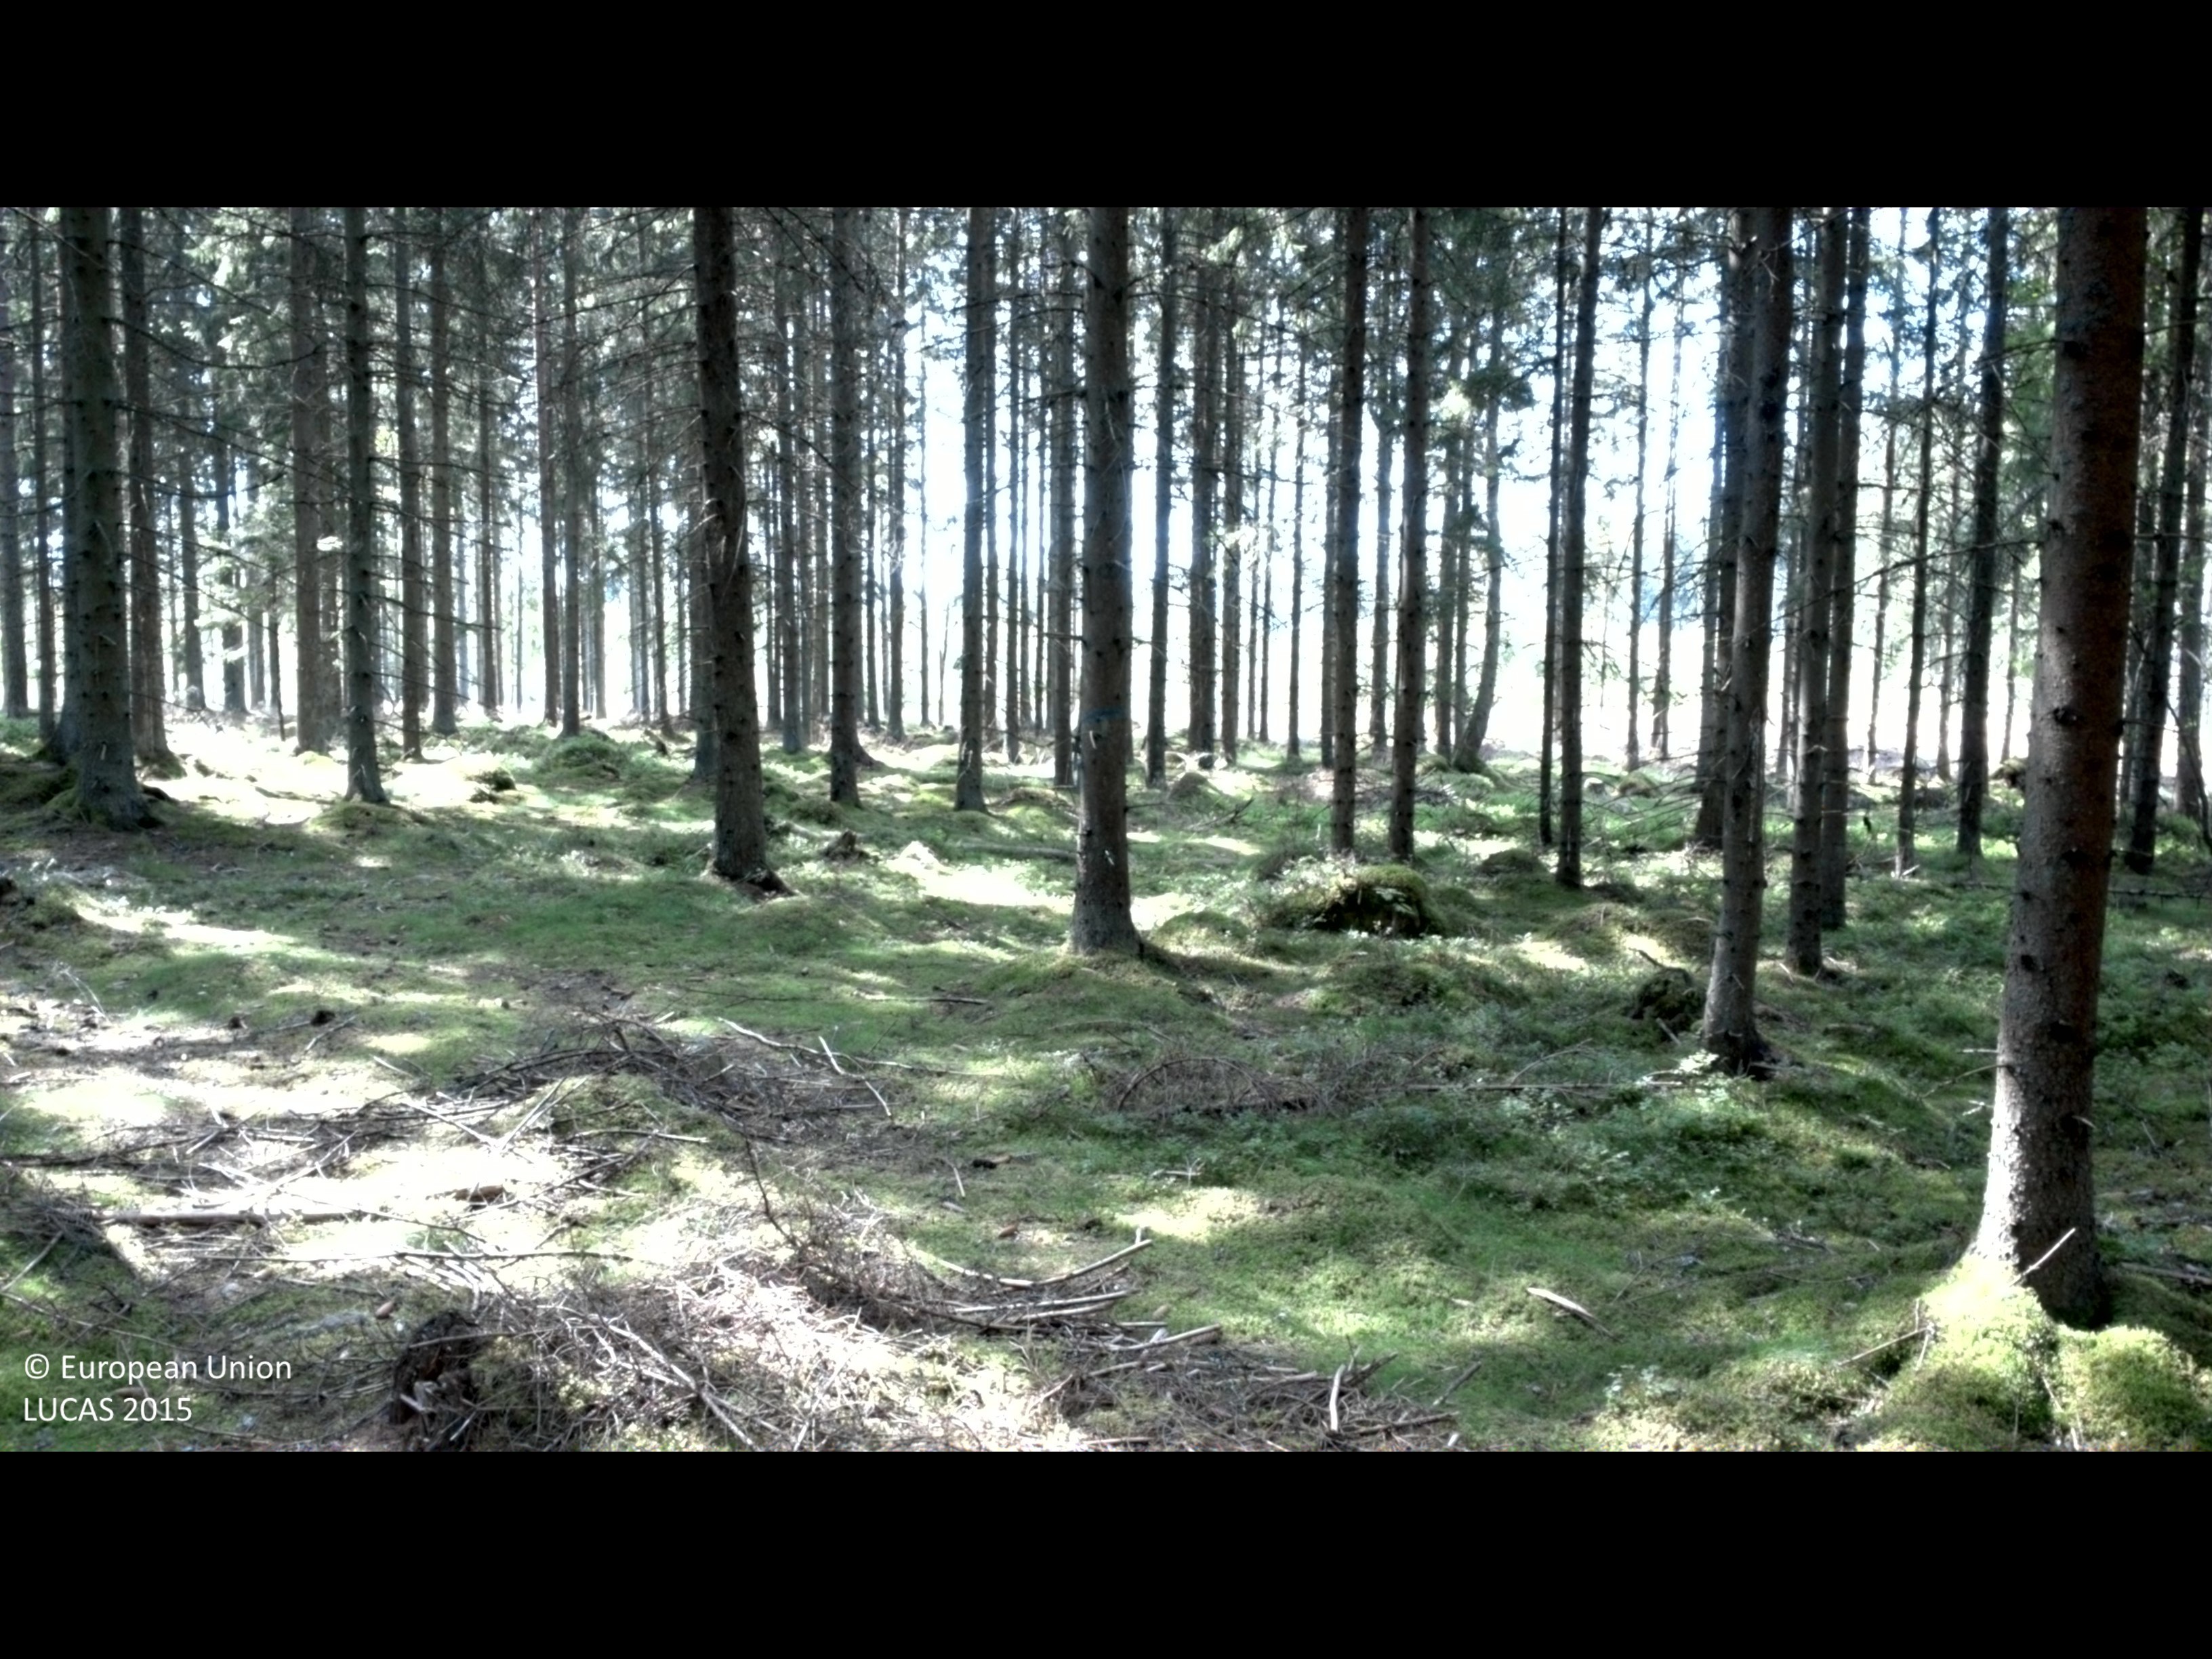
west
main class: Woodland
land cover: Spruce dominated coniferous woodland
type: boreal forest
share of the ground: > 75 %
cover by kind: coniferous forest trees 80 %, lichens and mosses 15 %, shrubs 5 %
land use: Forestry
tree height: > 5 m
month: August
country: SE
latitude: 56.8580
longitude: 14.1787
